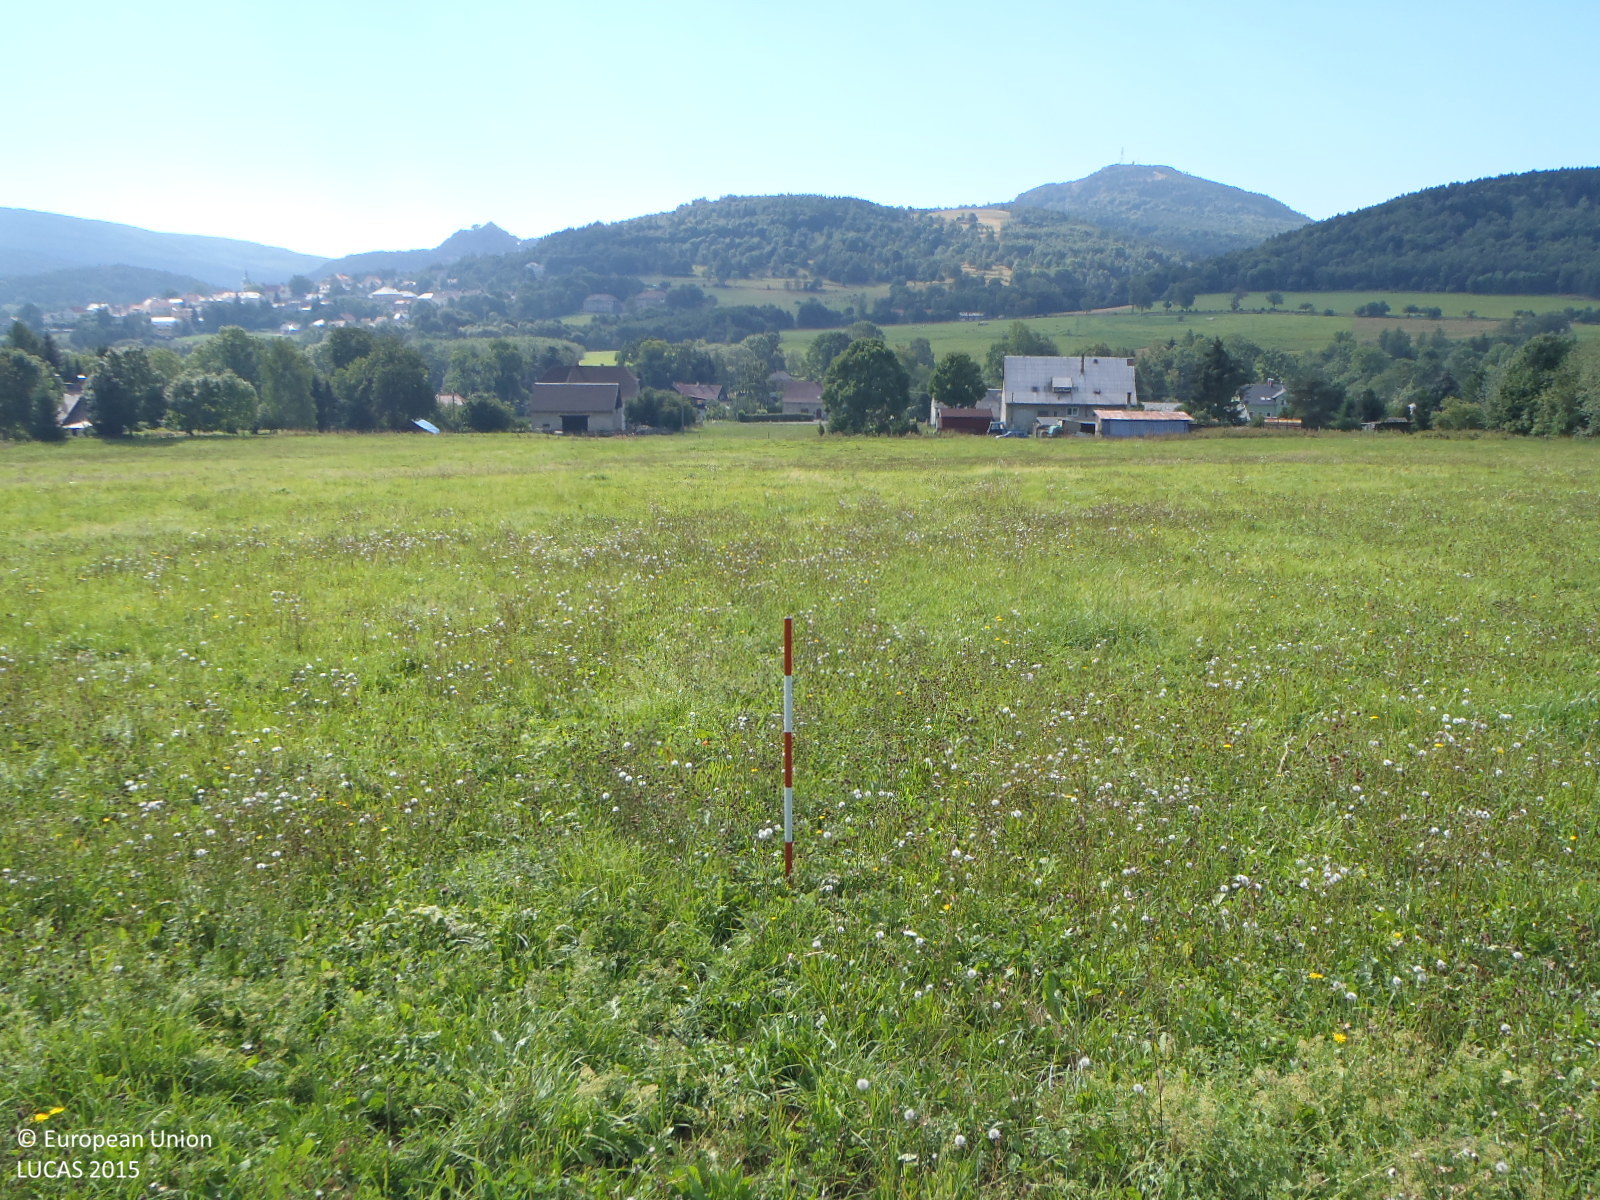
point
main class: Grassland
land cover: Grassland without tree/shrub cover
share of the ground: > 75 %
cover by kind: herbaceous plants 100 %
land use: Agriculture (excluding fallow land and kitchen gardens)
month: August
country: CZ
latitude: 50.8853
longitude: 14.5649
